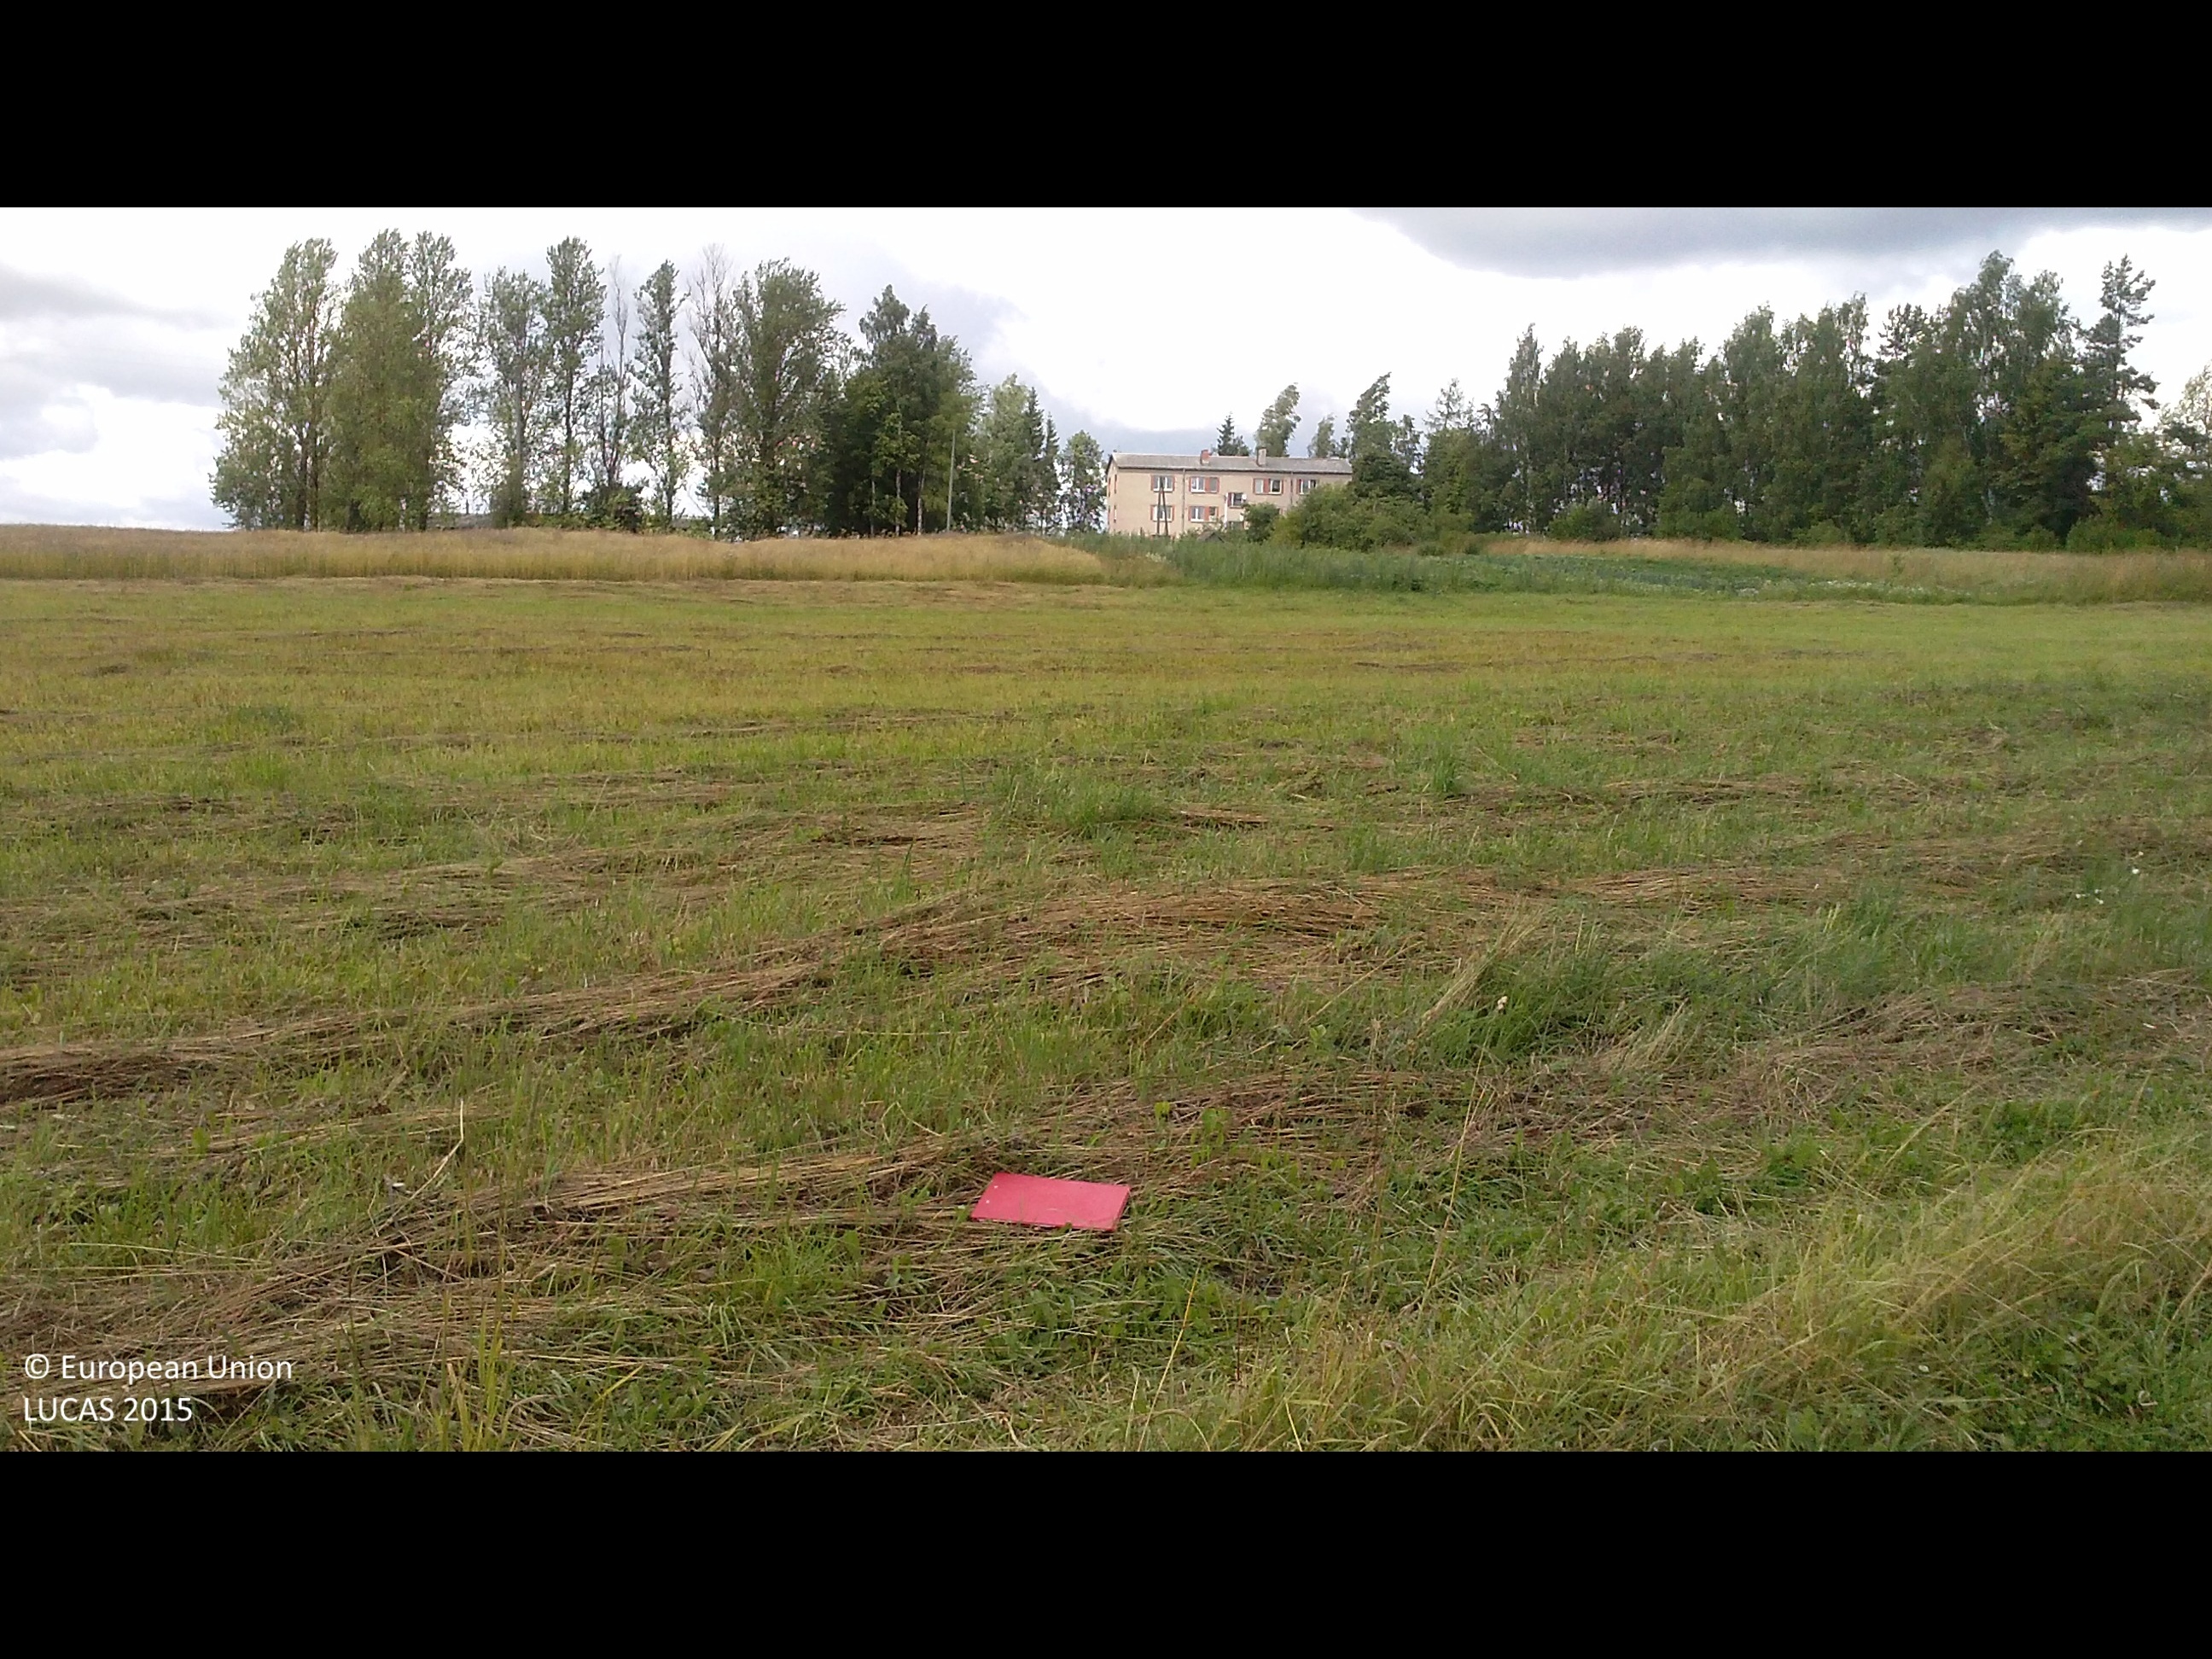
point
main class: Grassland
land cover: Grassland without tree/shrub cover
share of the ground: > 75 %
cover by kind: herbaceous plants 95 %, unconsolidated bare surface 5 %
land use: Agriculture (excluding fallow land and kitchen gardens)
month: July
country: LV
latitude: 56.4781
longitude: 26.9999
